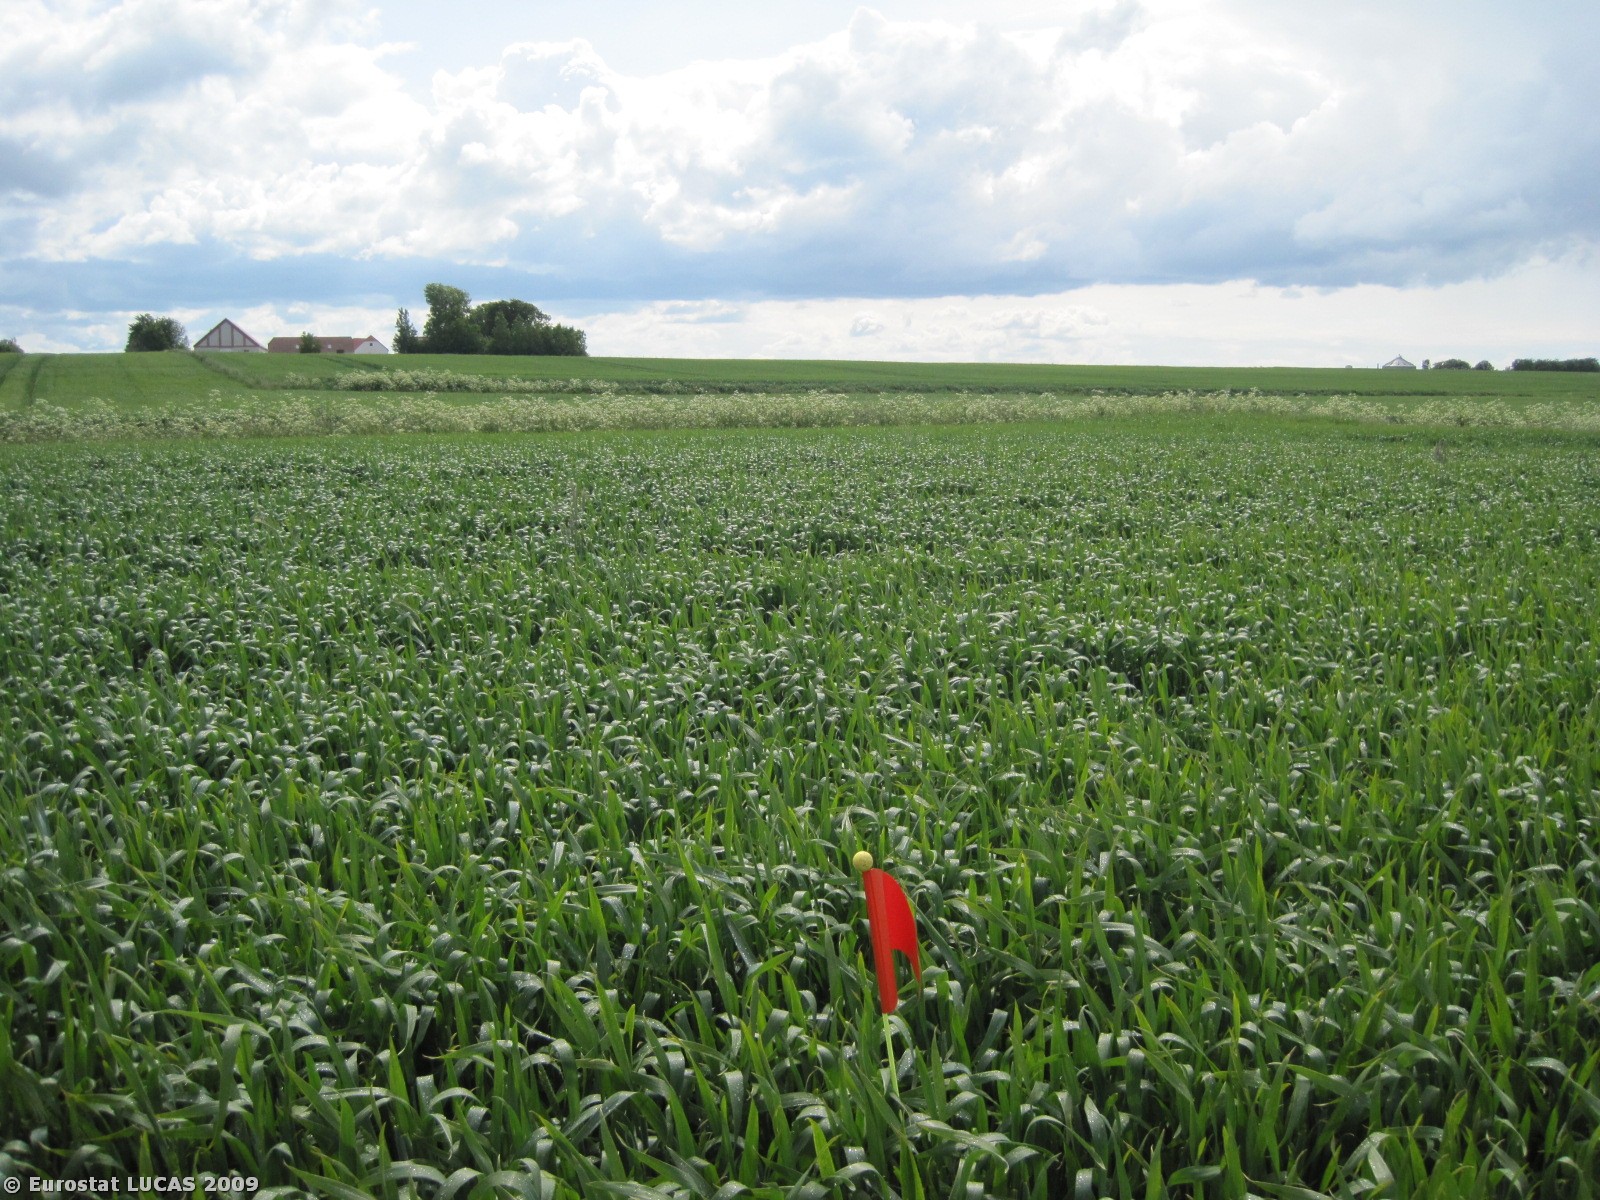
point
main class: Cropland
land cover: Common wheat
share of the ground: > 75 %
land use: Agriculture (excluding fallow land and kitchen gardens)
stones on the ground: < 10 %
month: June
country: DK
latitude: 57.3203
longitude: 9.8840
